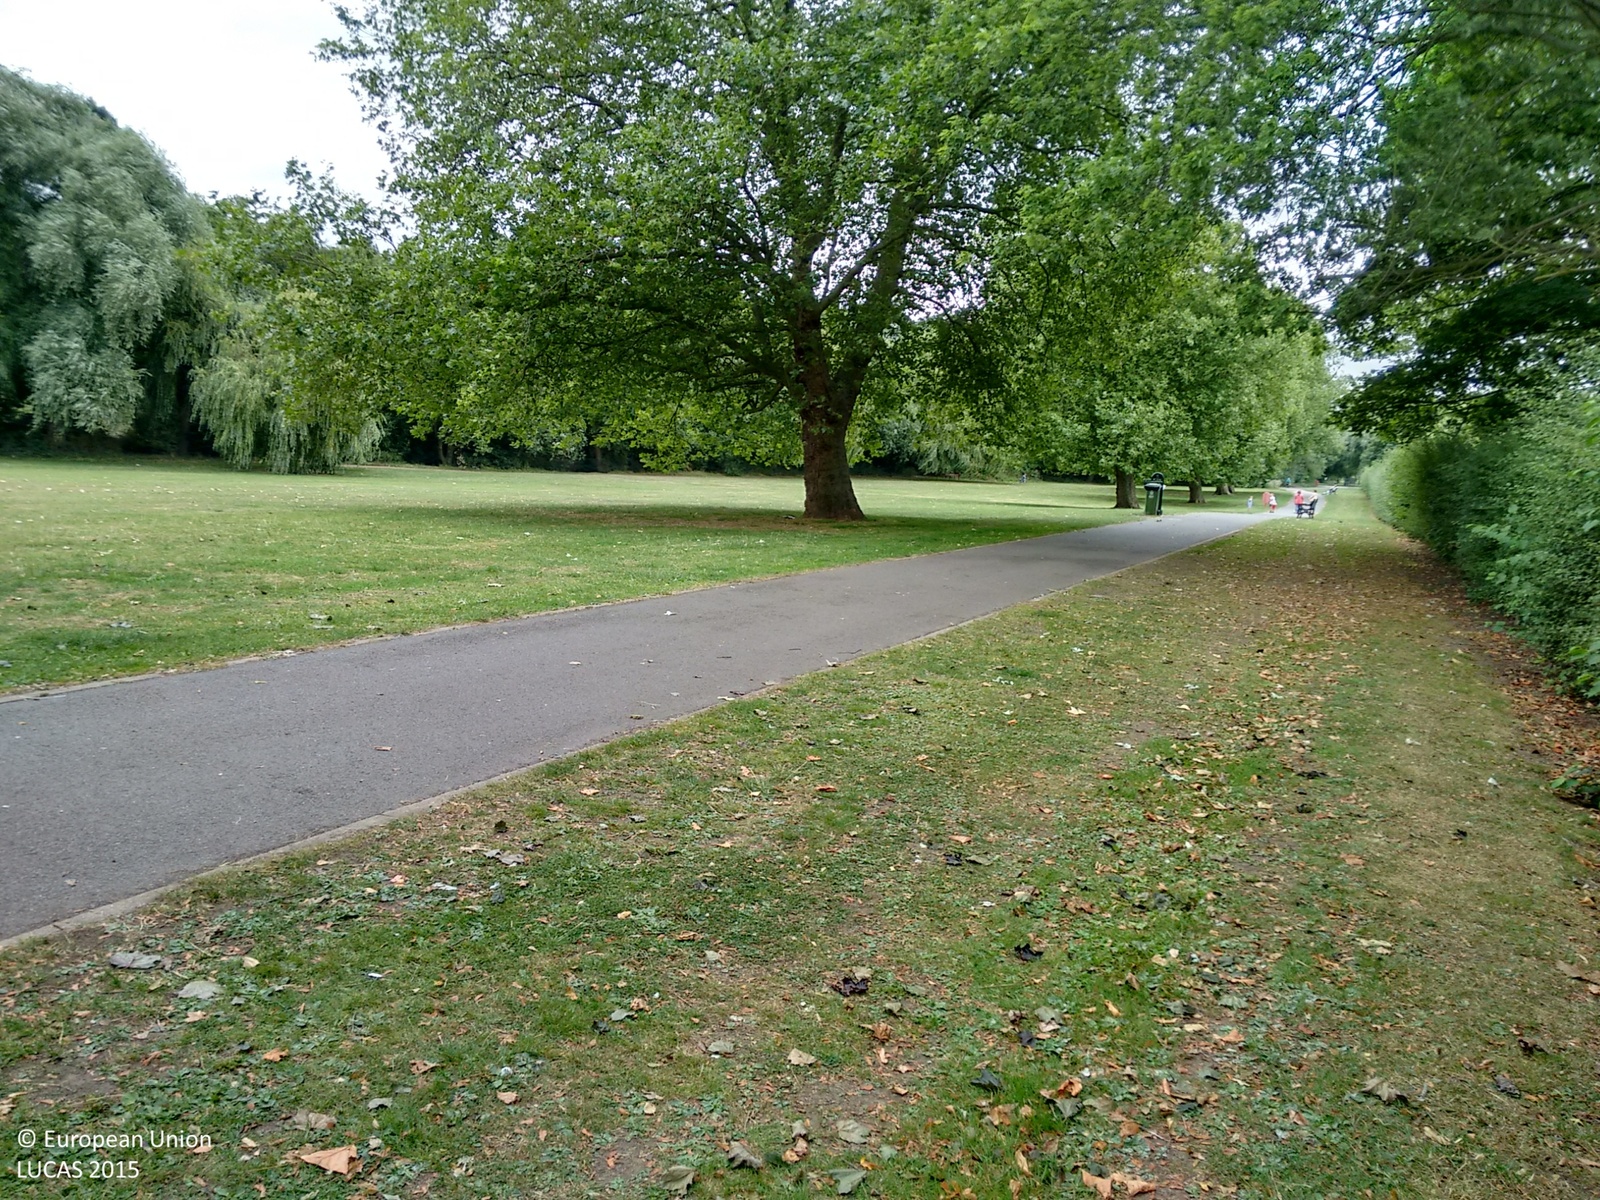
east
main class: Grassland
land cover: Grassland without tree/shrub cover
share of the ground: > 75 %
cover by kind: herbaceous plants 100 %
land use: Community services
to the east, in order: Grassland without tree/shrub cover; Fences; Managed hedges; Grass margins; Tracks; Grassland with sparse tree/shrub cover; Tracks; Broadleaved woodland; Rivers and streams; Broadleaved woodland; Fences; Broadleaved woodland
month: August
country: GB
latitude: 51.4563
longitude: 0.1100
